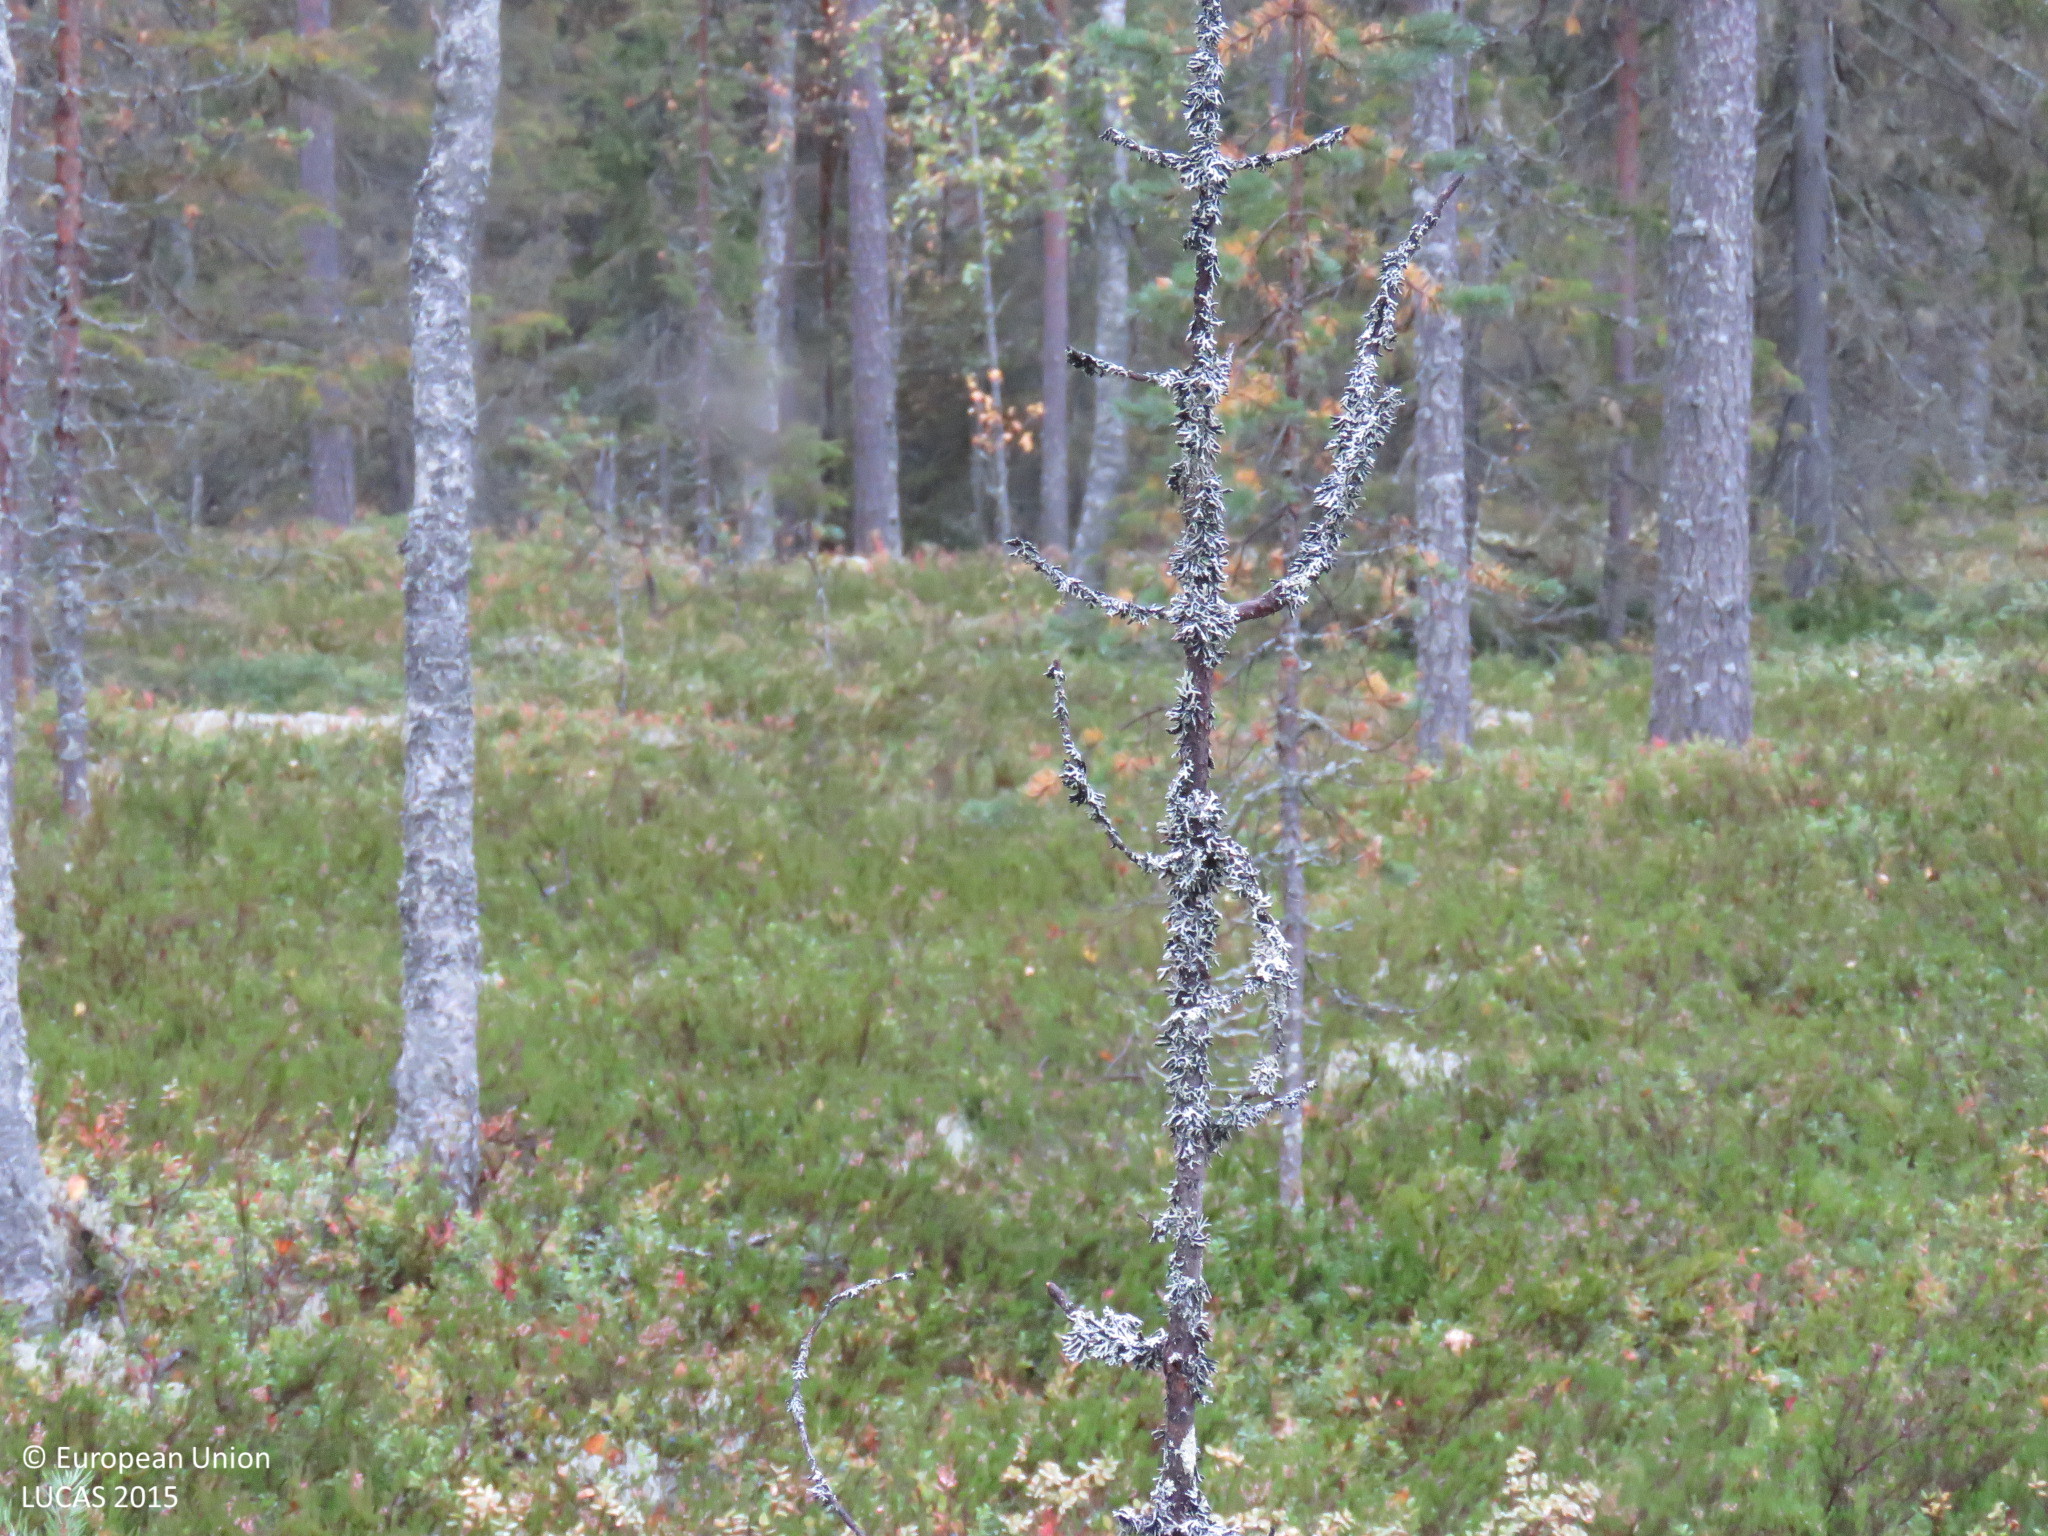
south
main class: Woodland
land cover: Other mixed woodland
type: boreal forest
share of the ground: 50 - 75 %
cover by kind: coniferous forest trees 45 %, broadleaved forest trees 25 %, shrubs 20 %, lichens and mosses 10 %
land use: Forestry
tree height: > 5 m
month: September
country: FI
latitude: 64.7960
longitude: 26.9387
